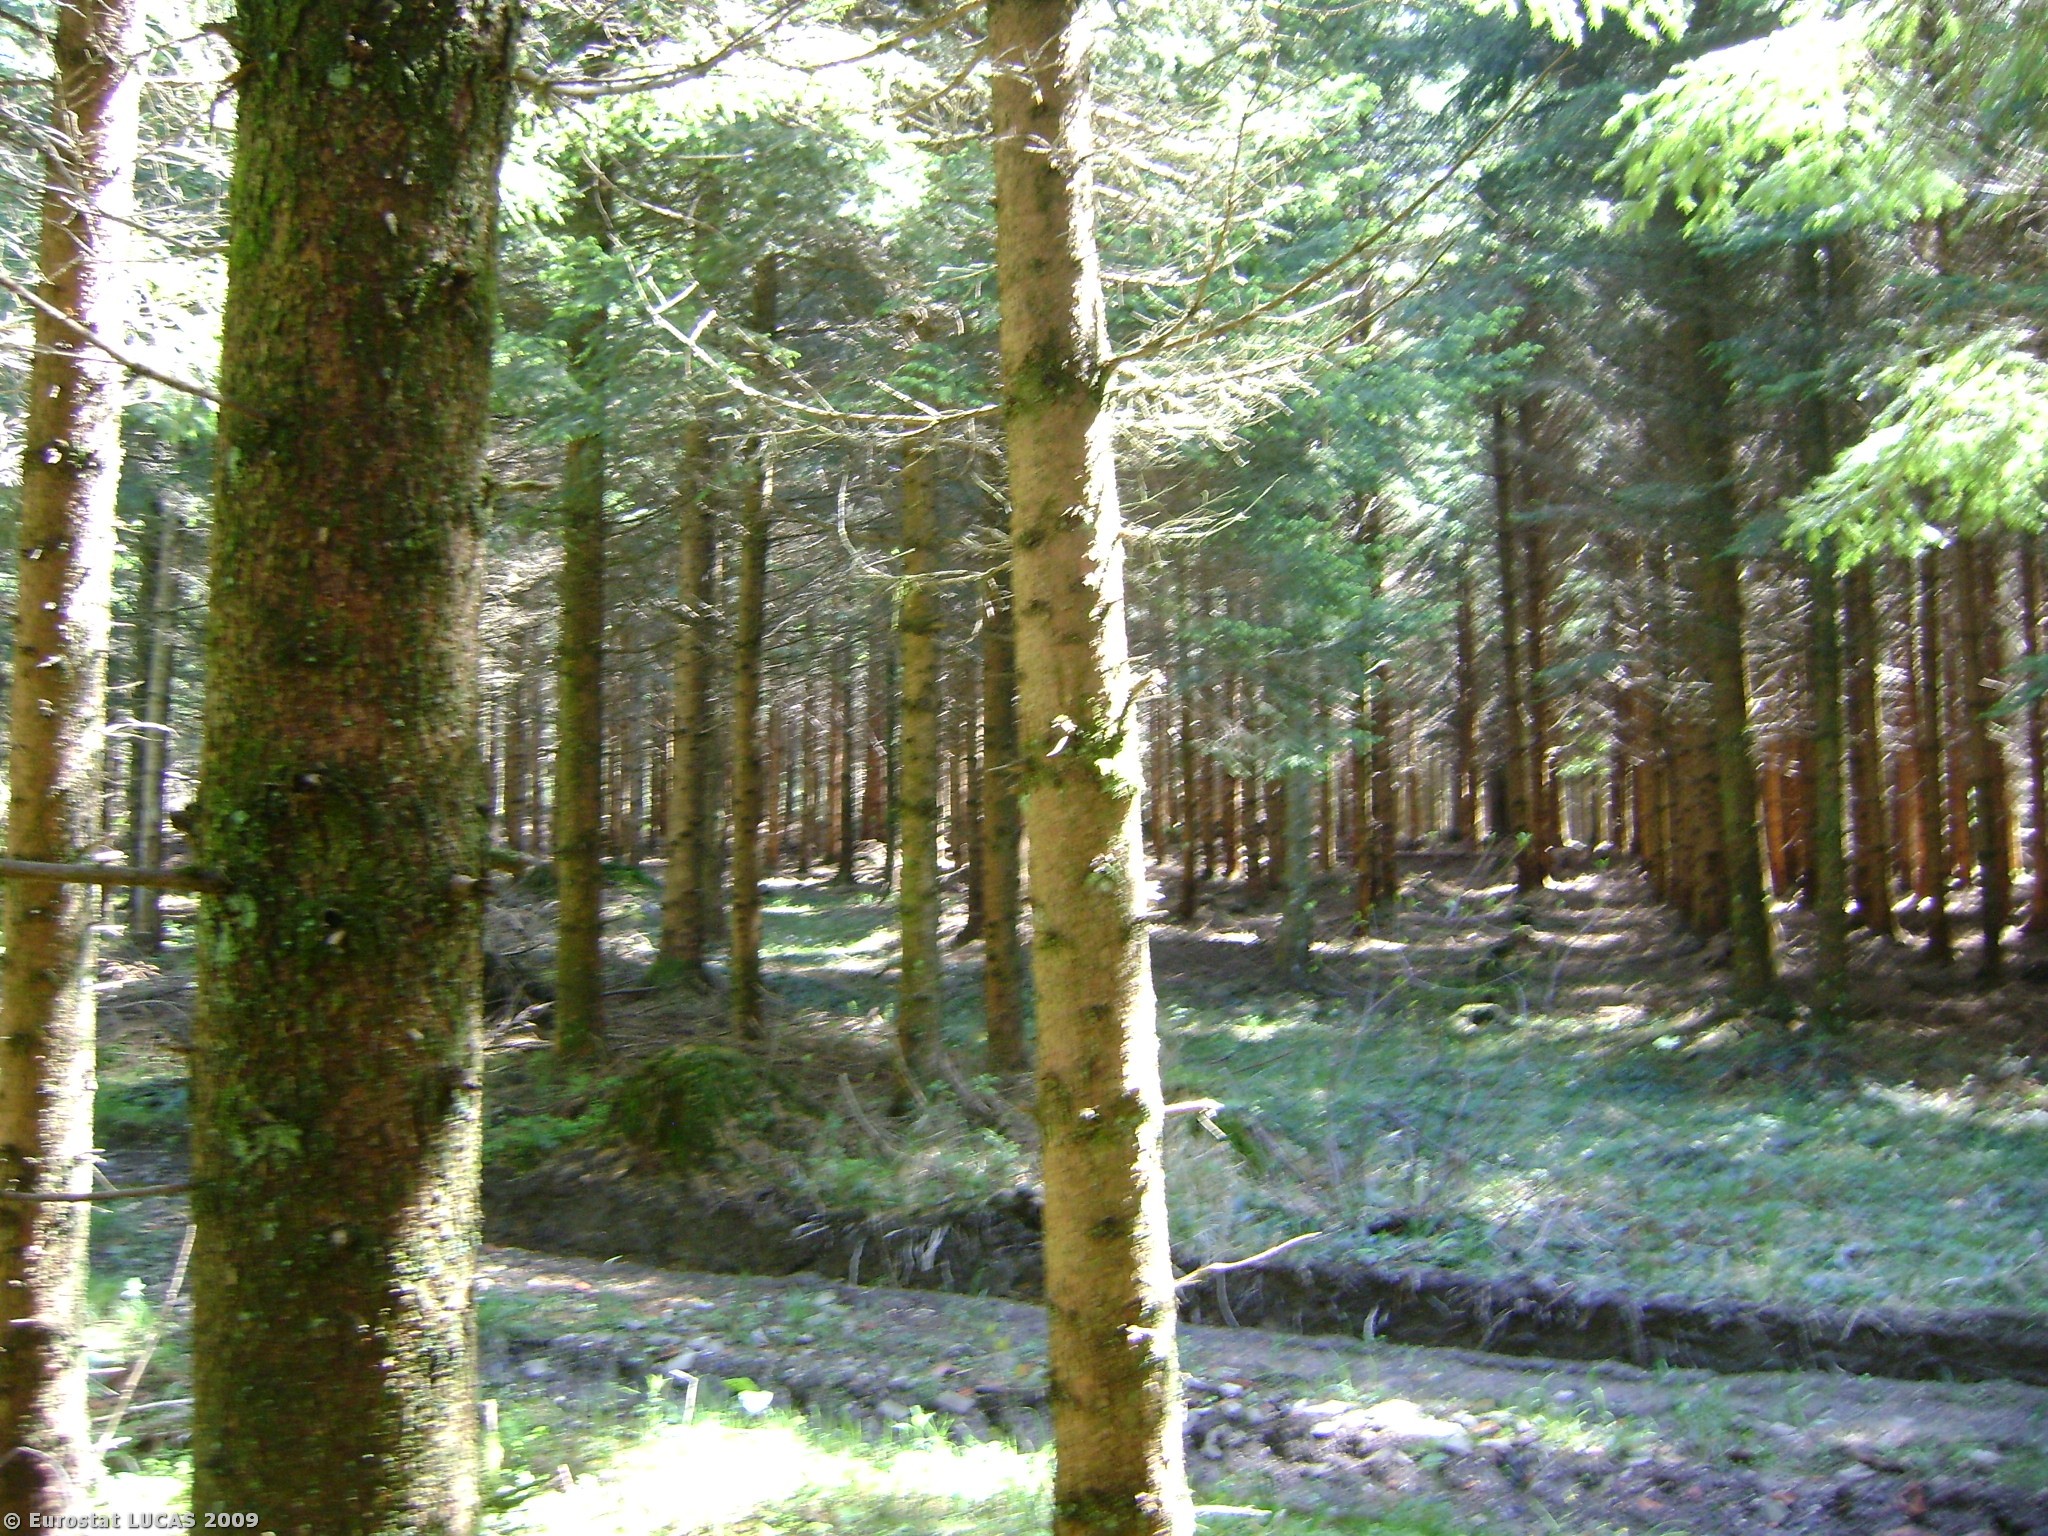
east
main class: Woodland
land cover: Coniferous woodland
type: hemiboreal forest and nemoral coniferous forest and mixed broadleaved-coniferous forest
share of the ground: > 75 %
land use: Forestry
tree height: > 5 m
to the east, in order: Coniferous woodland; Tracks; Coniferous woodland; Ditches and canals; Coniferous woodland; Tracks; Coniferous woodland; Tracks; Coniferous woodland
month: May
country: AT
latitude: 47.8516
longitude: 13.2463
